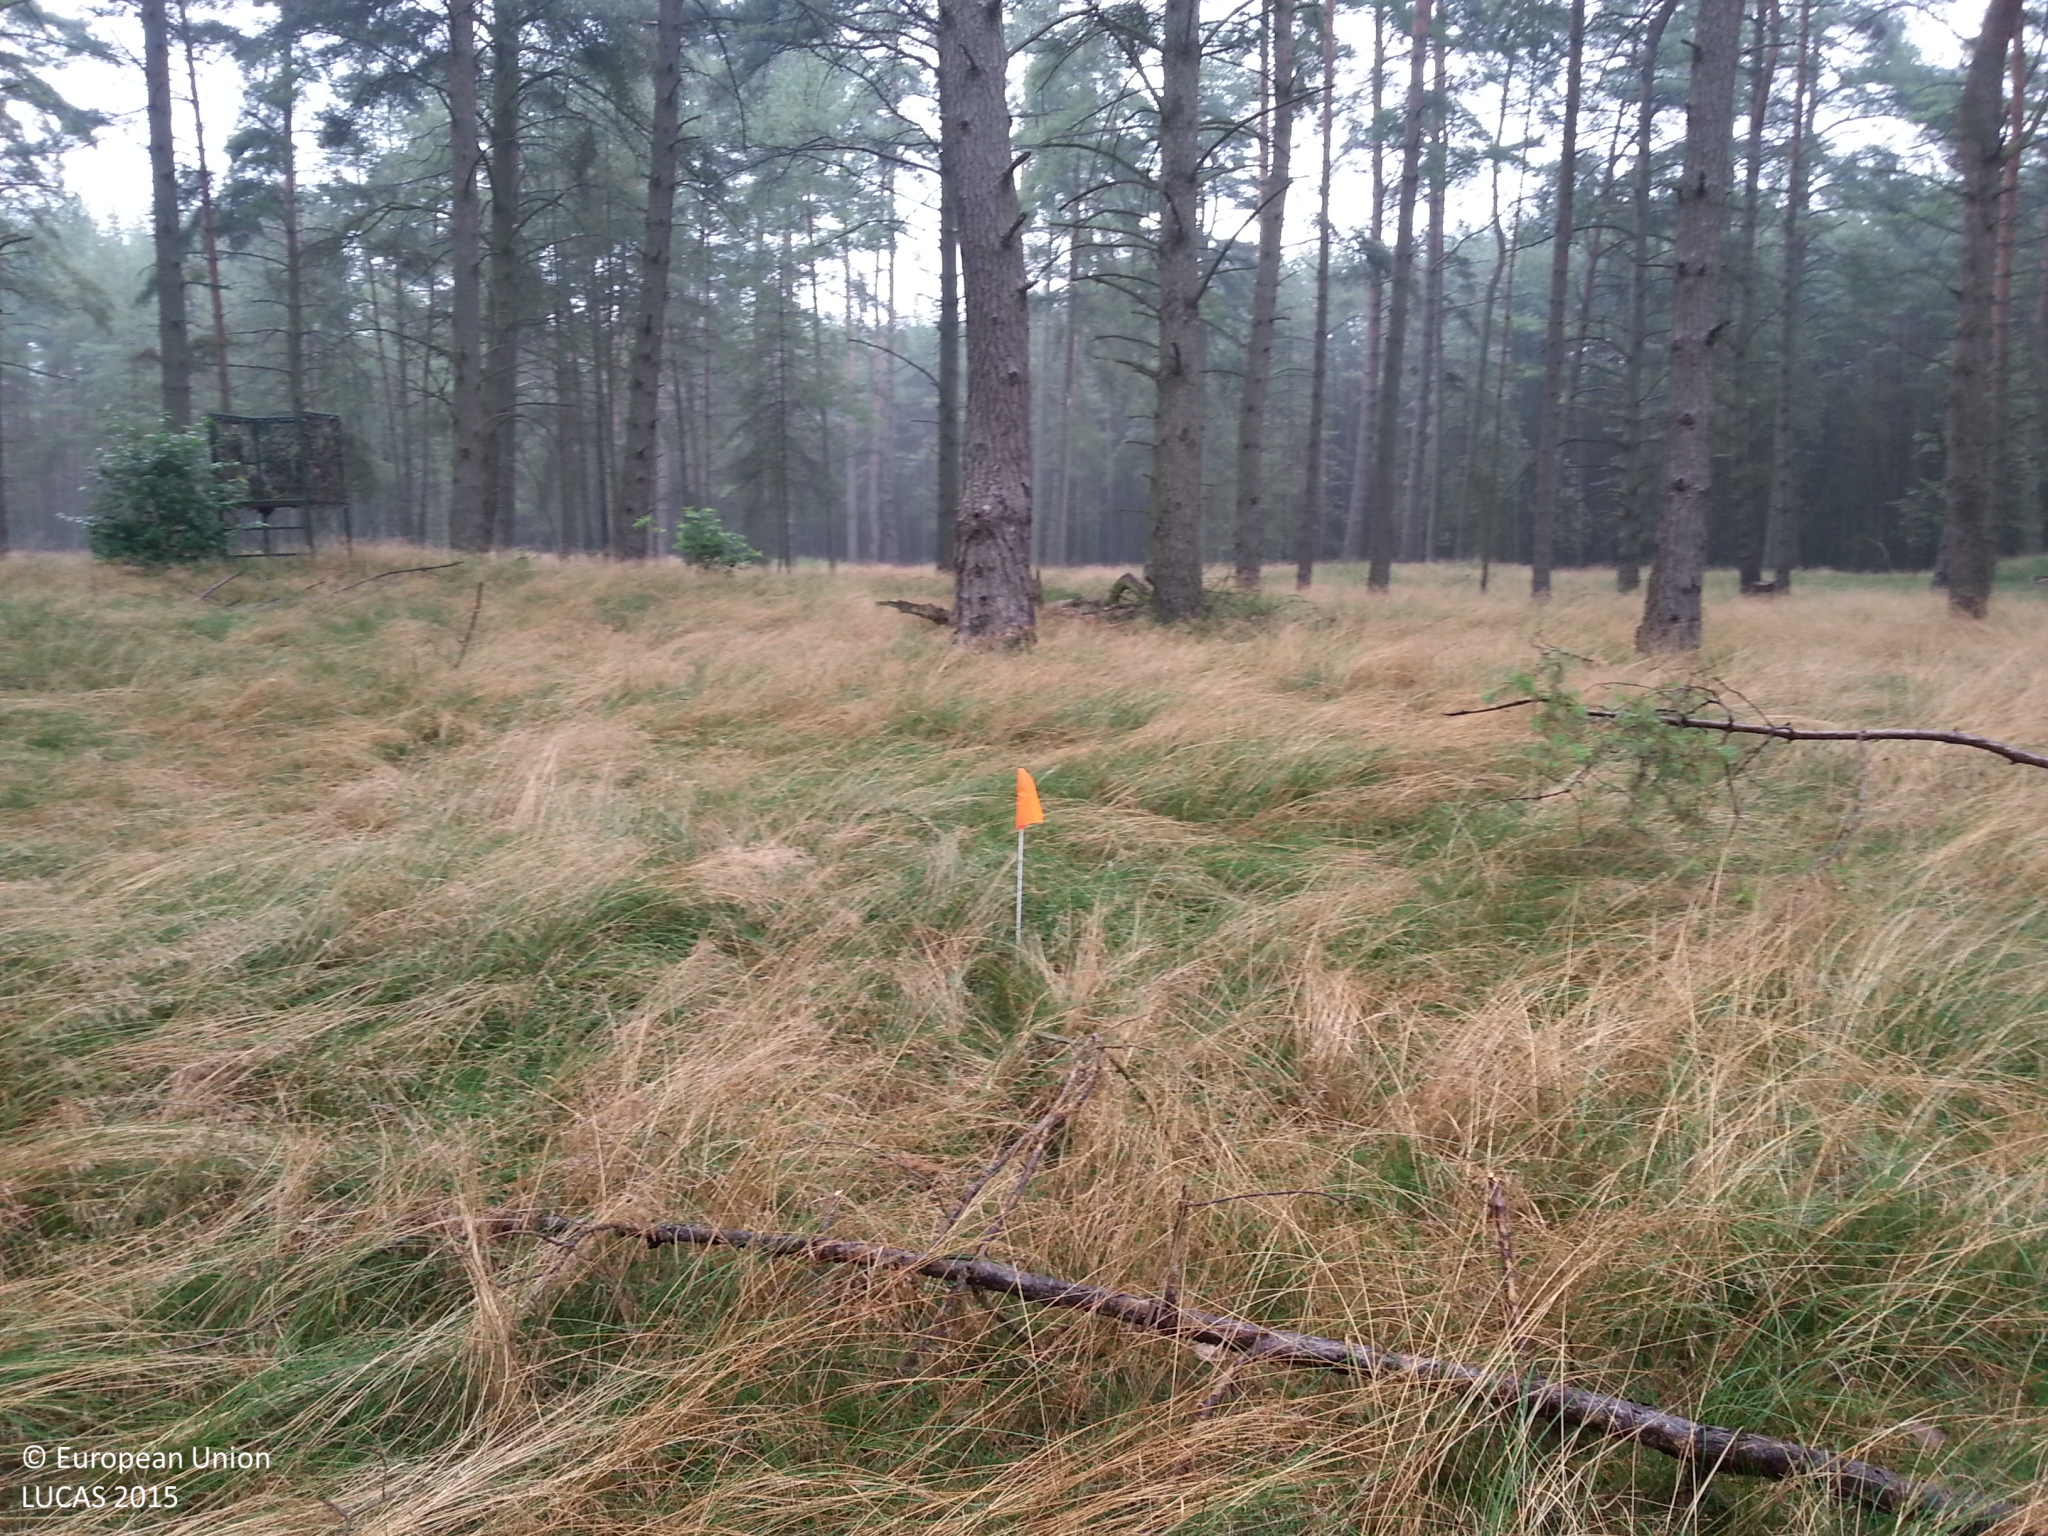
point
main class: Woodland
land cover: Pine dominated coniferous woodland
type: hemiboreal forest and nemoral coniferous forest and mixed broadleaved-coniferous forest
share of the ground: 50 - 75 %
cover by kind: coniferous forest trees 65 %, herbaceous plants 35 %
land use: Forestry
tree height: > 5 m
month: August
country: DE
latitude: 53.1951
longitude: 11.4813
